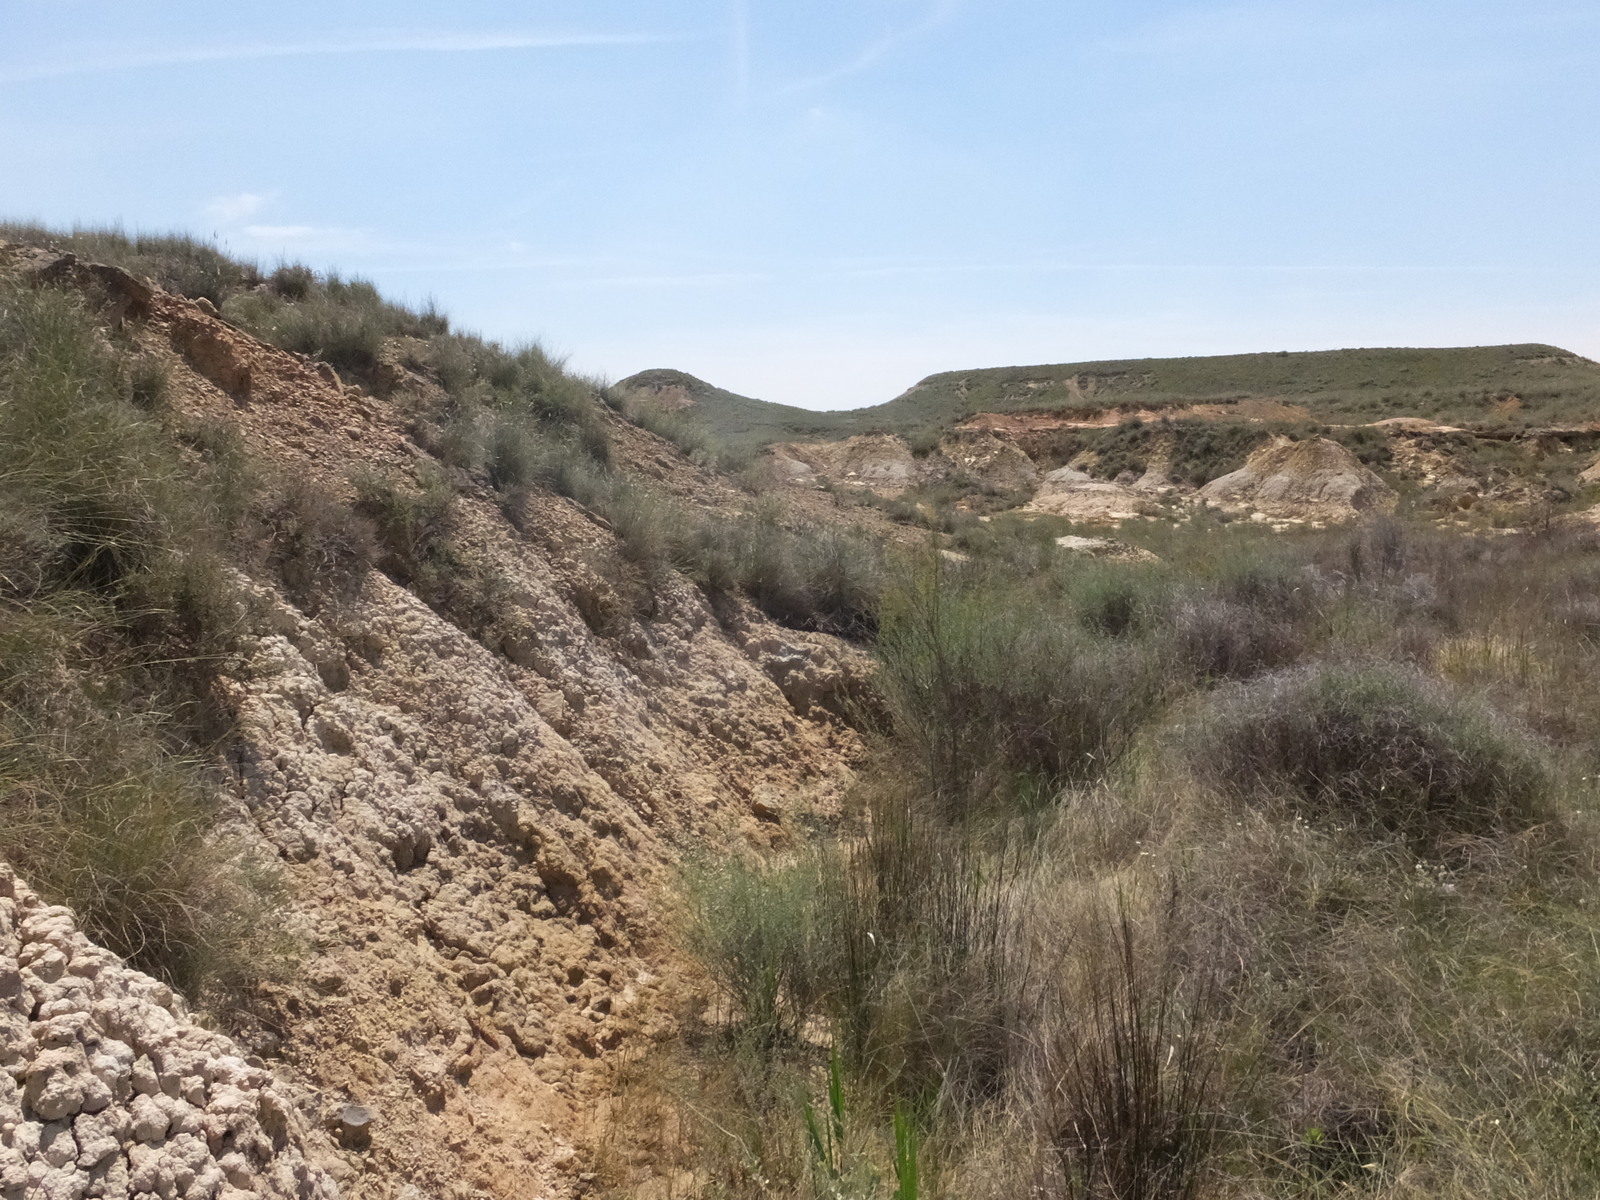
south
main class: Grassland
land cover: Grassland without tree/shrub cover
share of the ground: 50 - 75 %
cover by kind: herbaceous plants 65 %, unconsolidated bare surface 30 %, shrubs 5 %
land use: Semi-natural and natural areas not in use
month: April
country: ES
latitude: 41.7398
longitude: -0.1779
